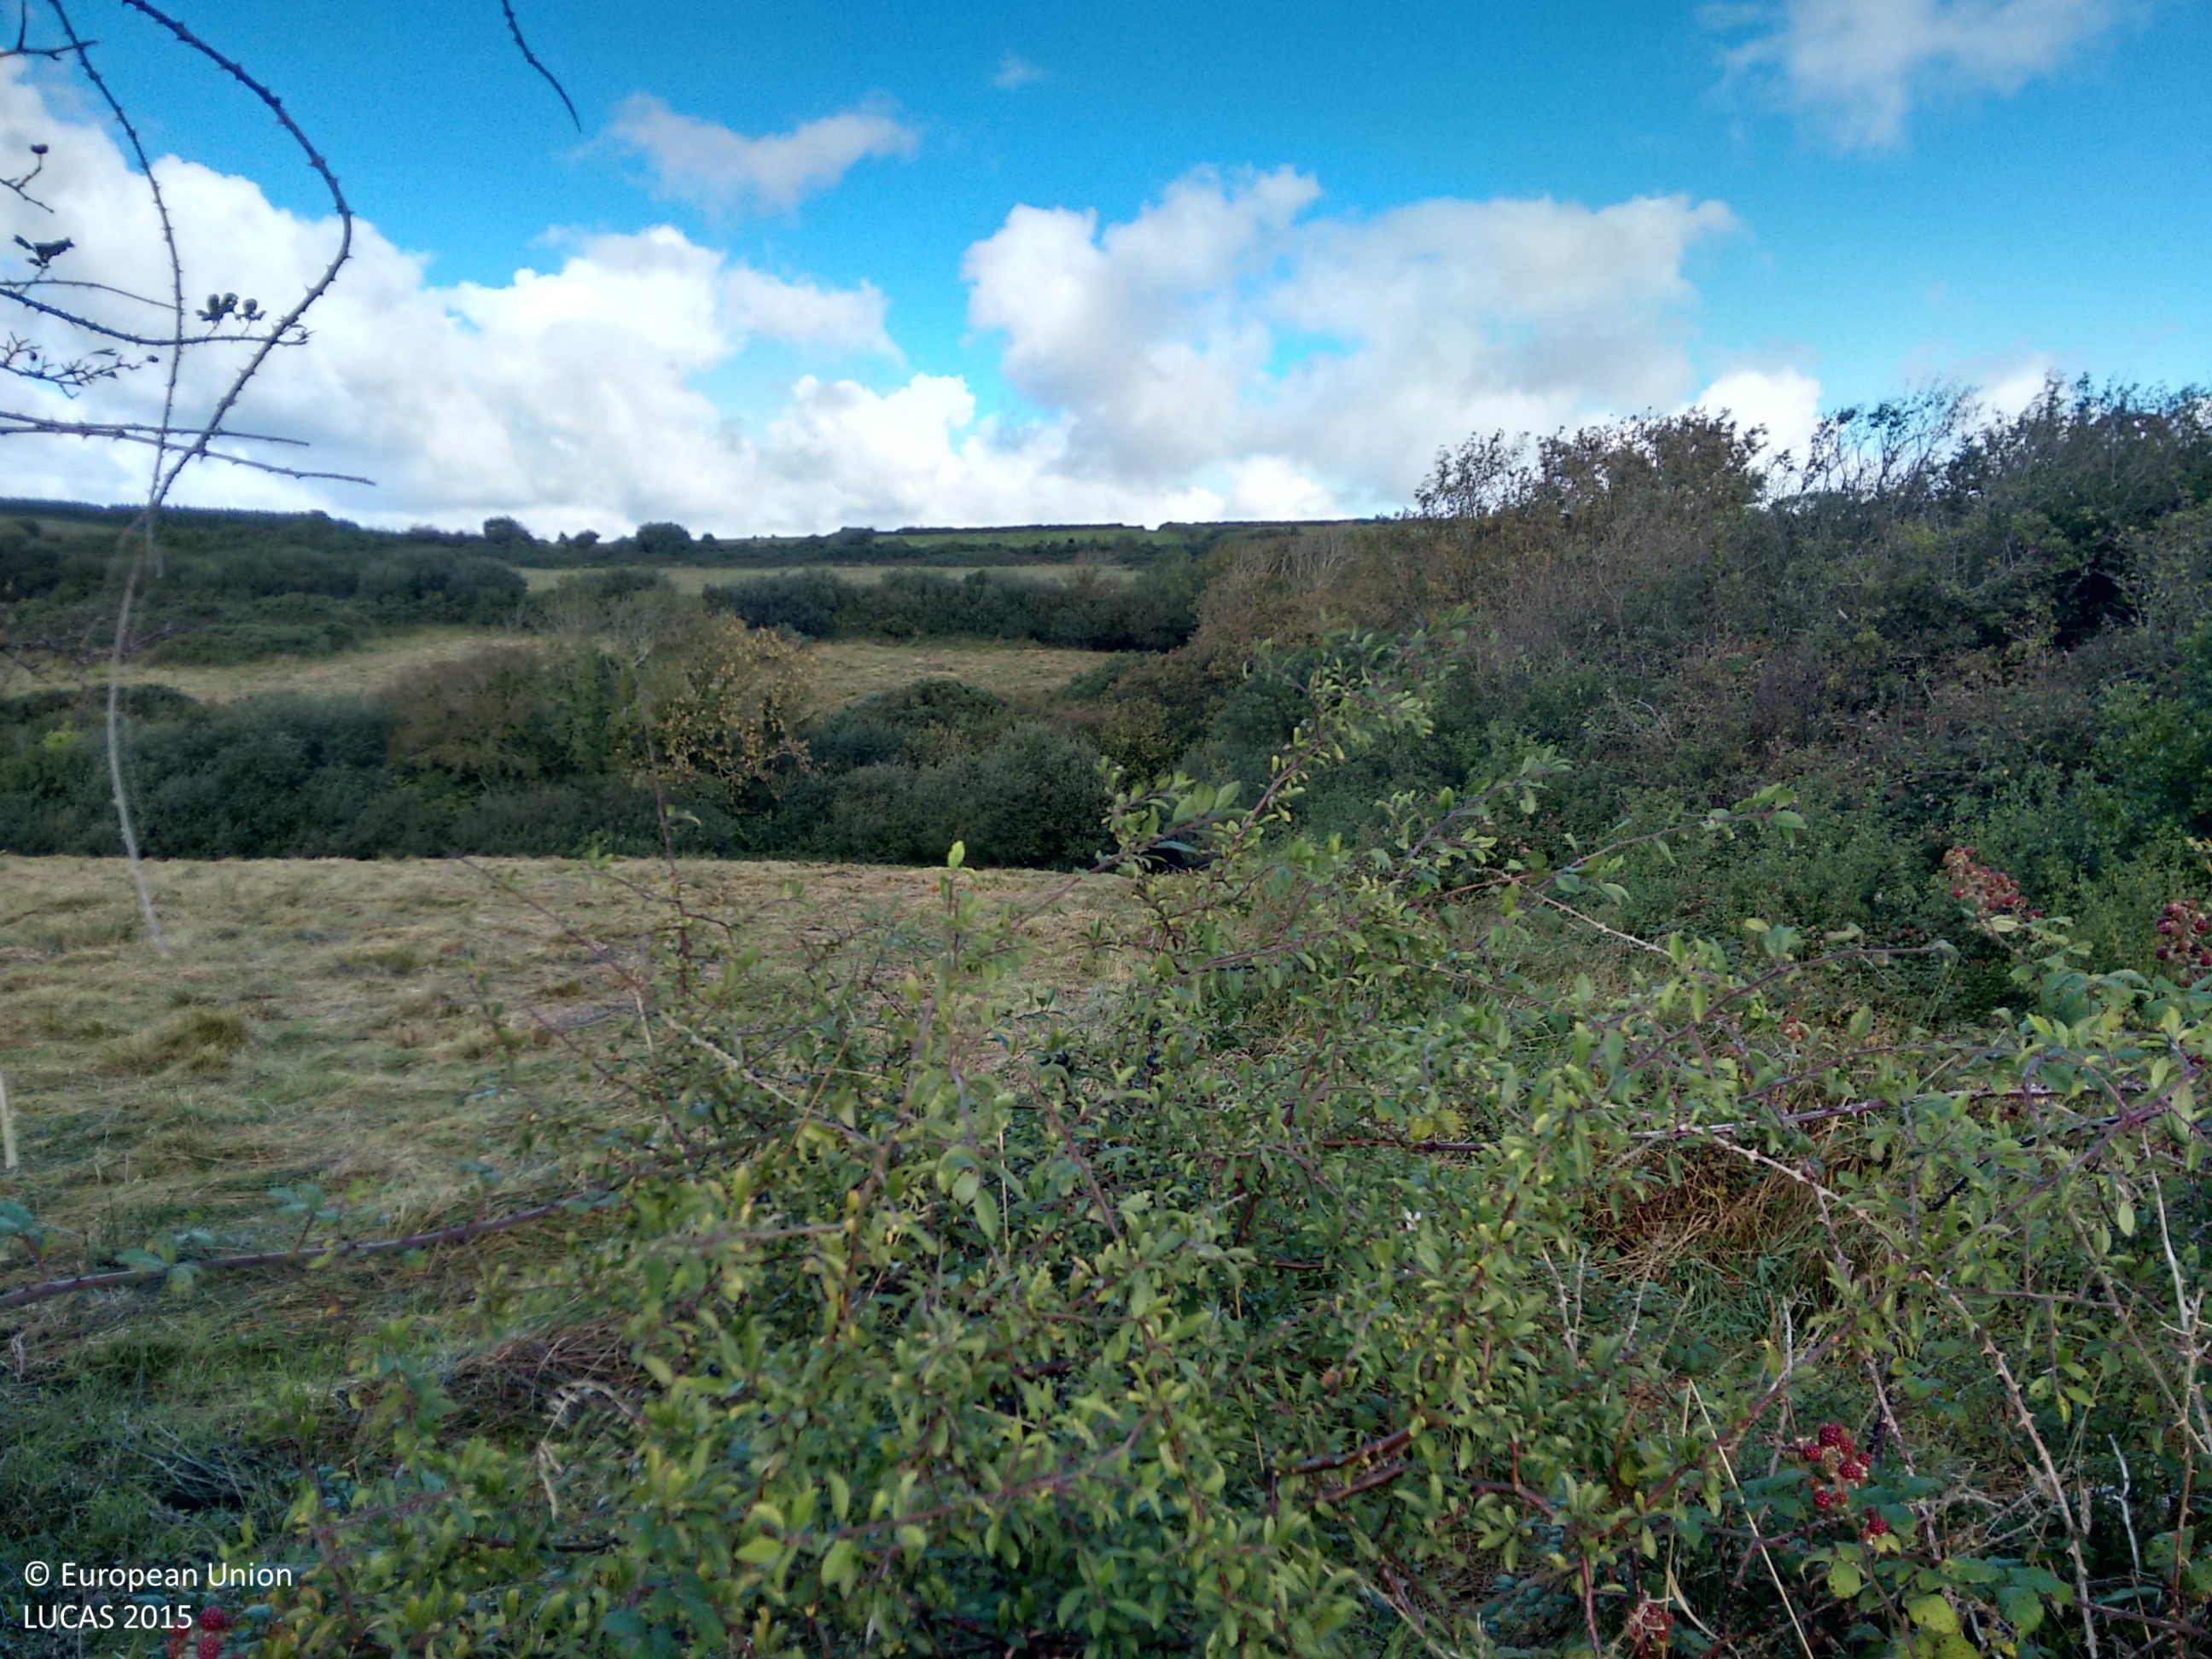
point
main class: Grassland
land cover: Grassland without tree/shrub cover
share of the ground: > 75 %
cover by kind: herbaceous plants 100 %
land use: Agriculture (excluding fallow land and kitchen gardens)
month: September
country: IE
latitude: 52.6253
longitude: -9.1734
